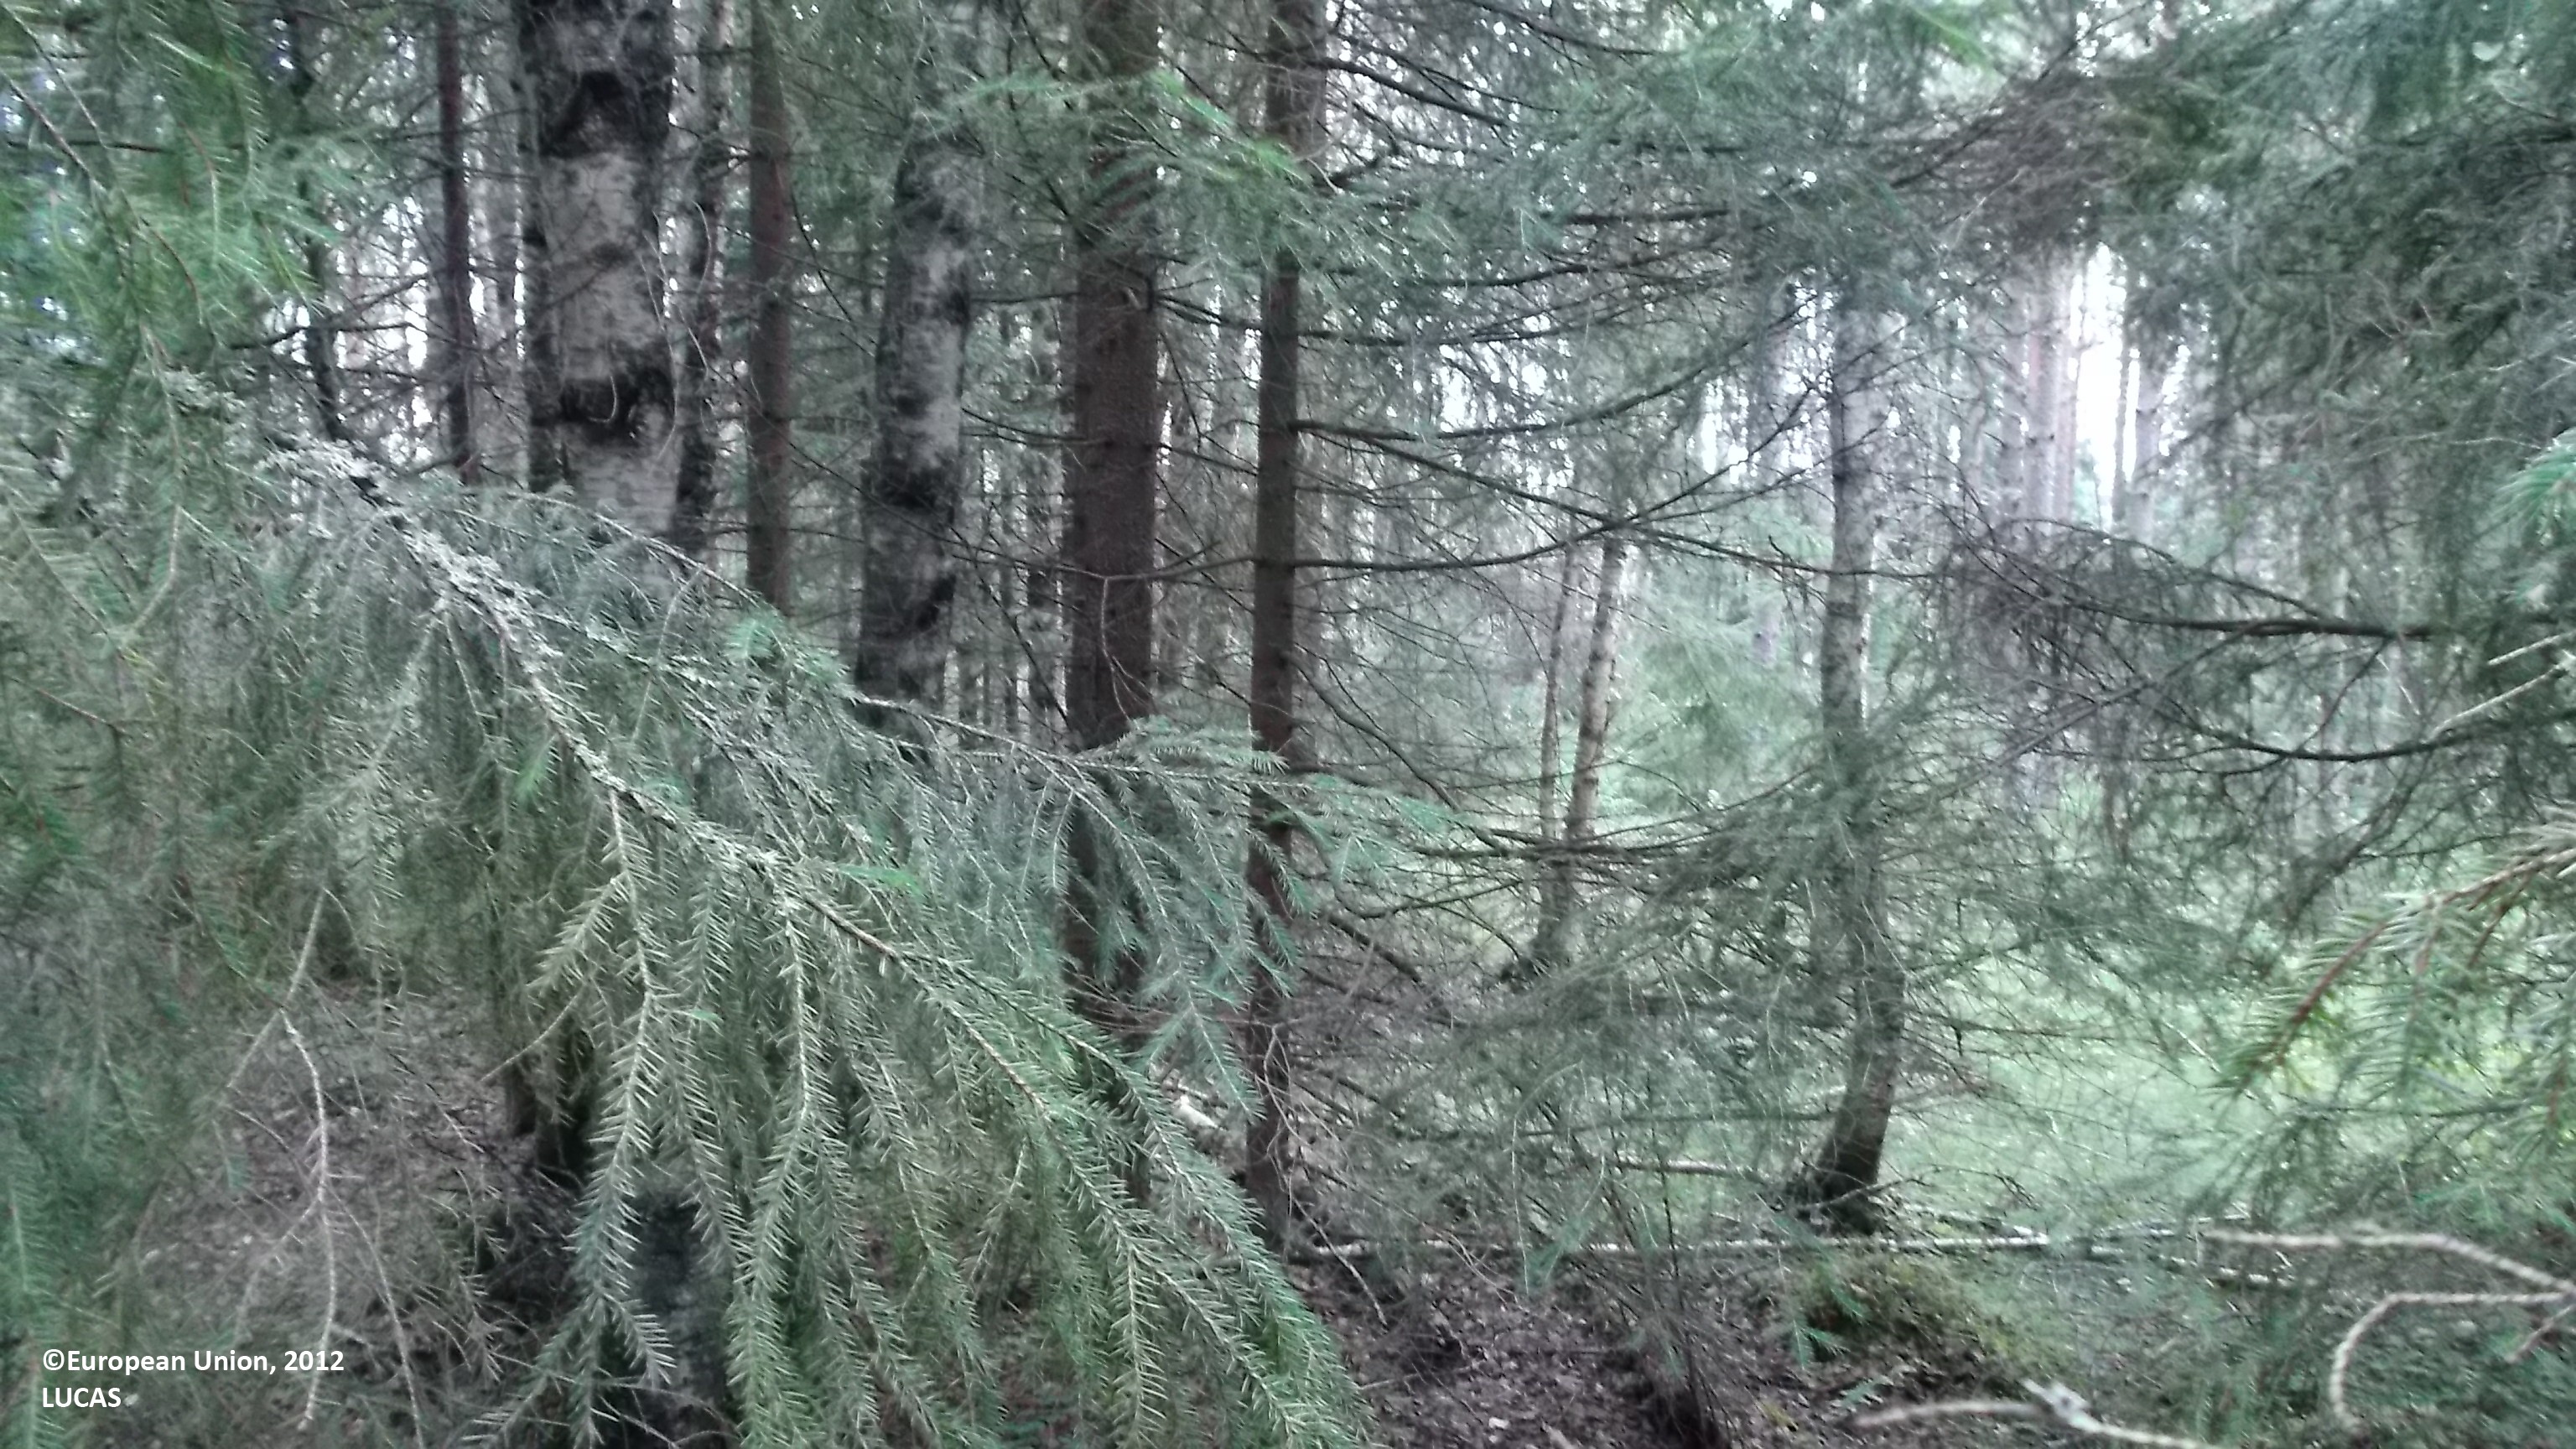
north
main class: Woodland
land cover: Other mixed woodland
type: boreal forest
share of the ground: > 75 %
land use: Forestry
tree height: > 5 m
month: July
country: FI
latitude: 63.3611
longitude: 23.8835
